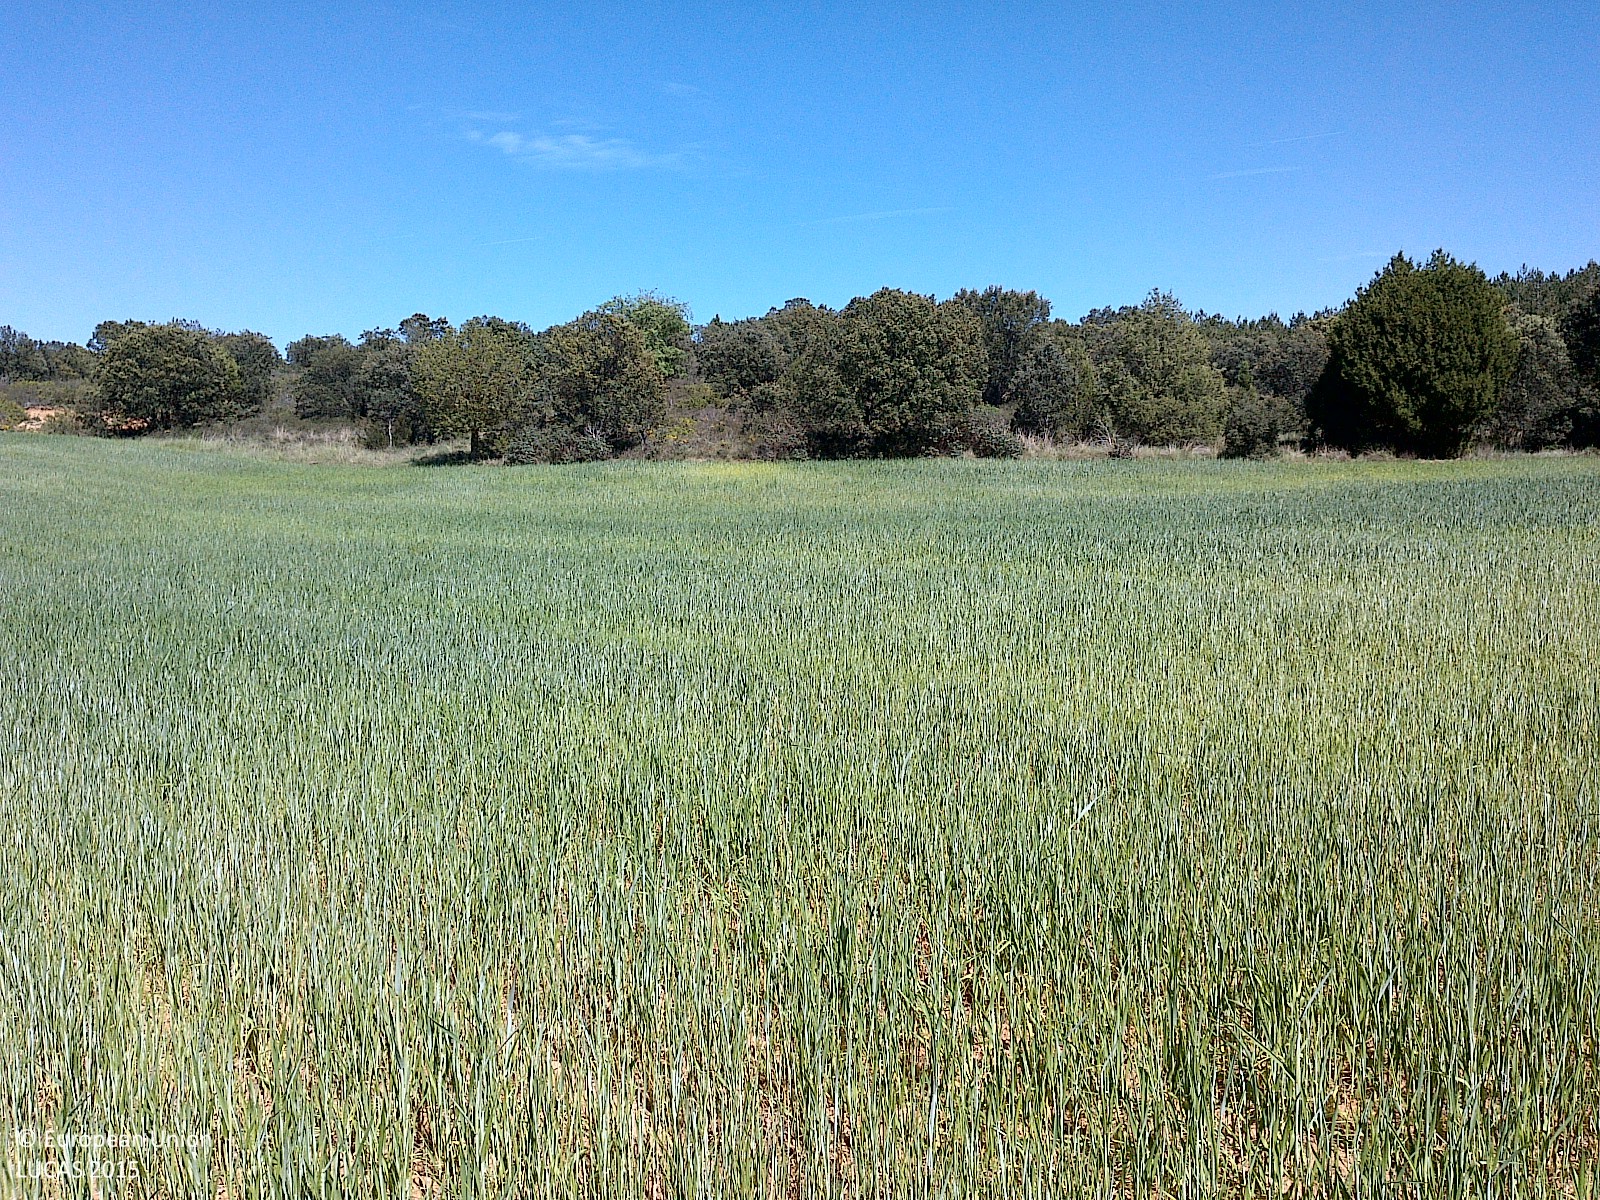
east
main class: Cropland
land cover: Barley
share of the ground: > 75 %
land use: Agriculture (excluding fallow land and kitchen gardens)
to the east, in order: Barley; Other mixed woodland; Broadleaved woodland; Pine dominated coniferous woodland
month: May
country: ES
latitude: 41.6147
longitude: -3.1129
